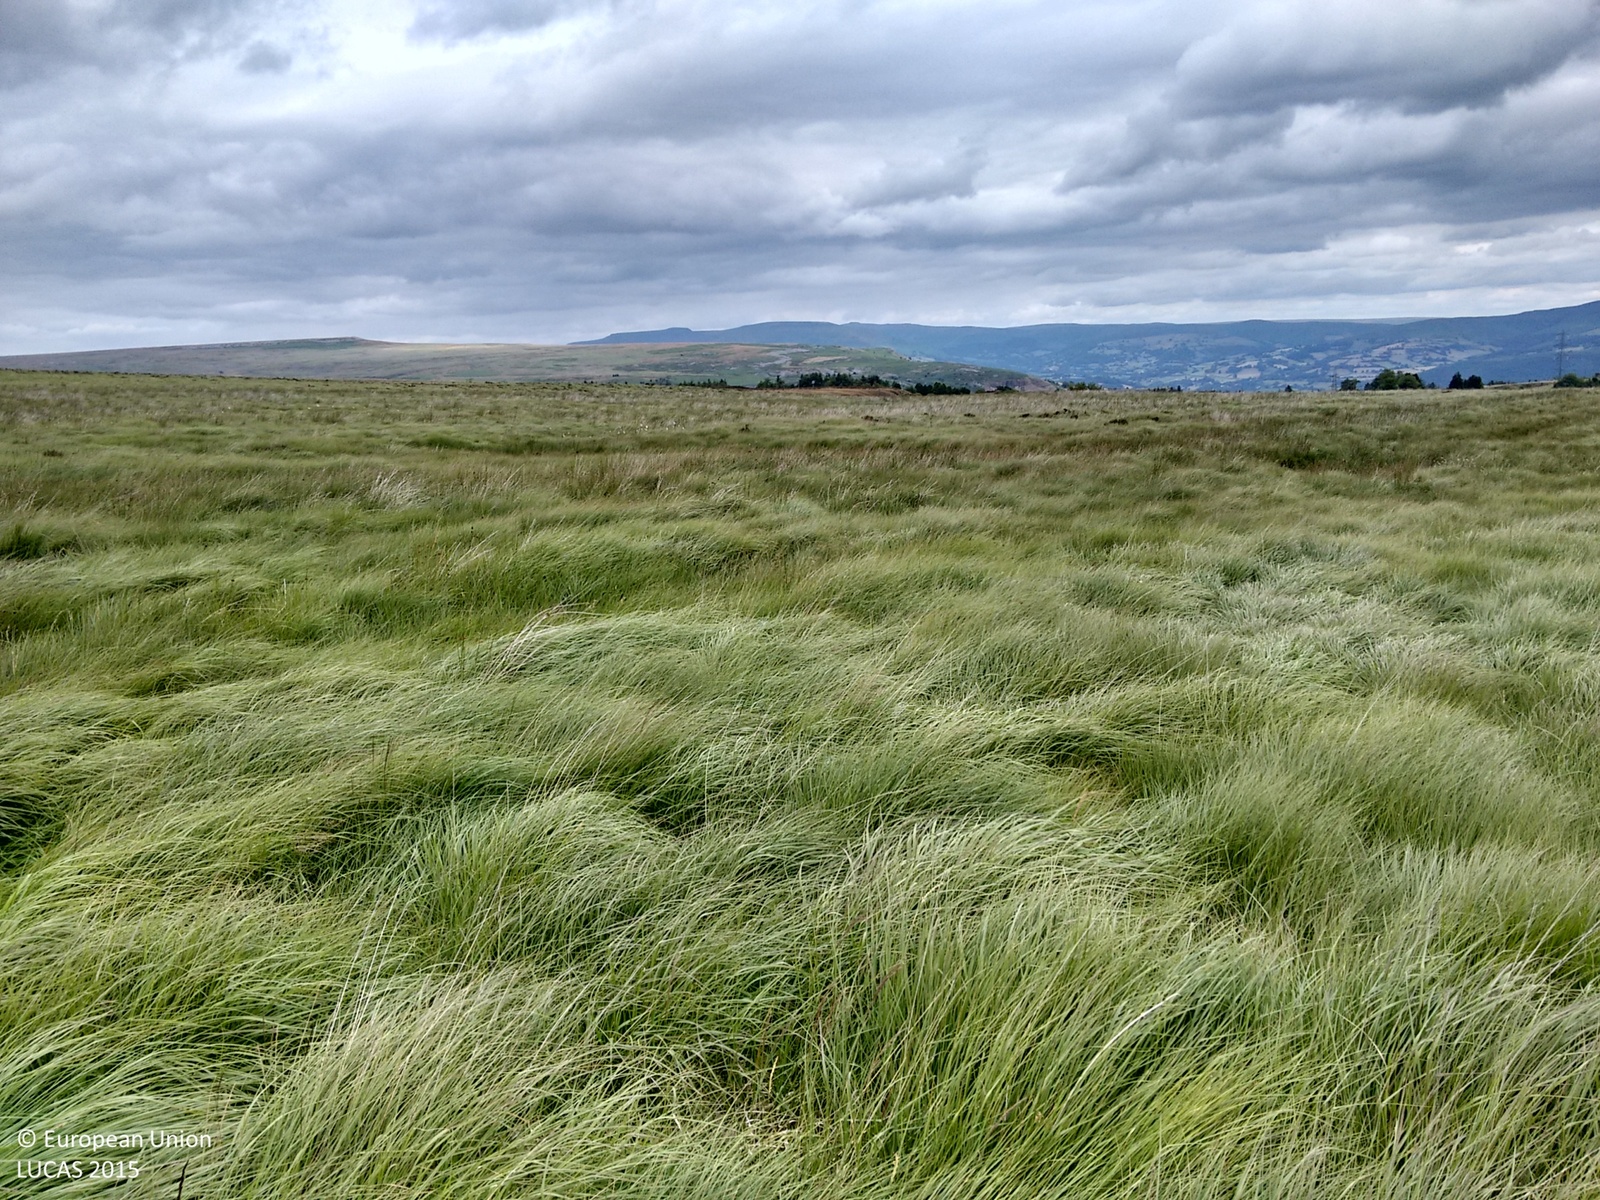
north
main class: Grassland
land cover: Grassland without tree/shrub cover
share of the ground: > 75 %
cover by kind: herbaceous plants 100 %
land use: Semi-natural and natural areas not in use
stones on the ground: < 10 %
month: July
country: GB
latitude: 51.7888
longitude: -3.1400
